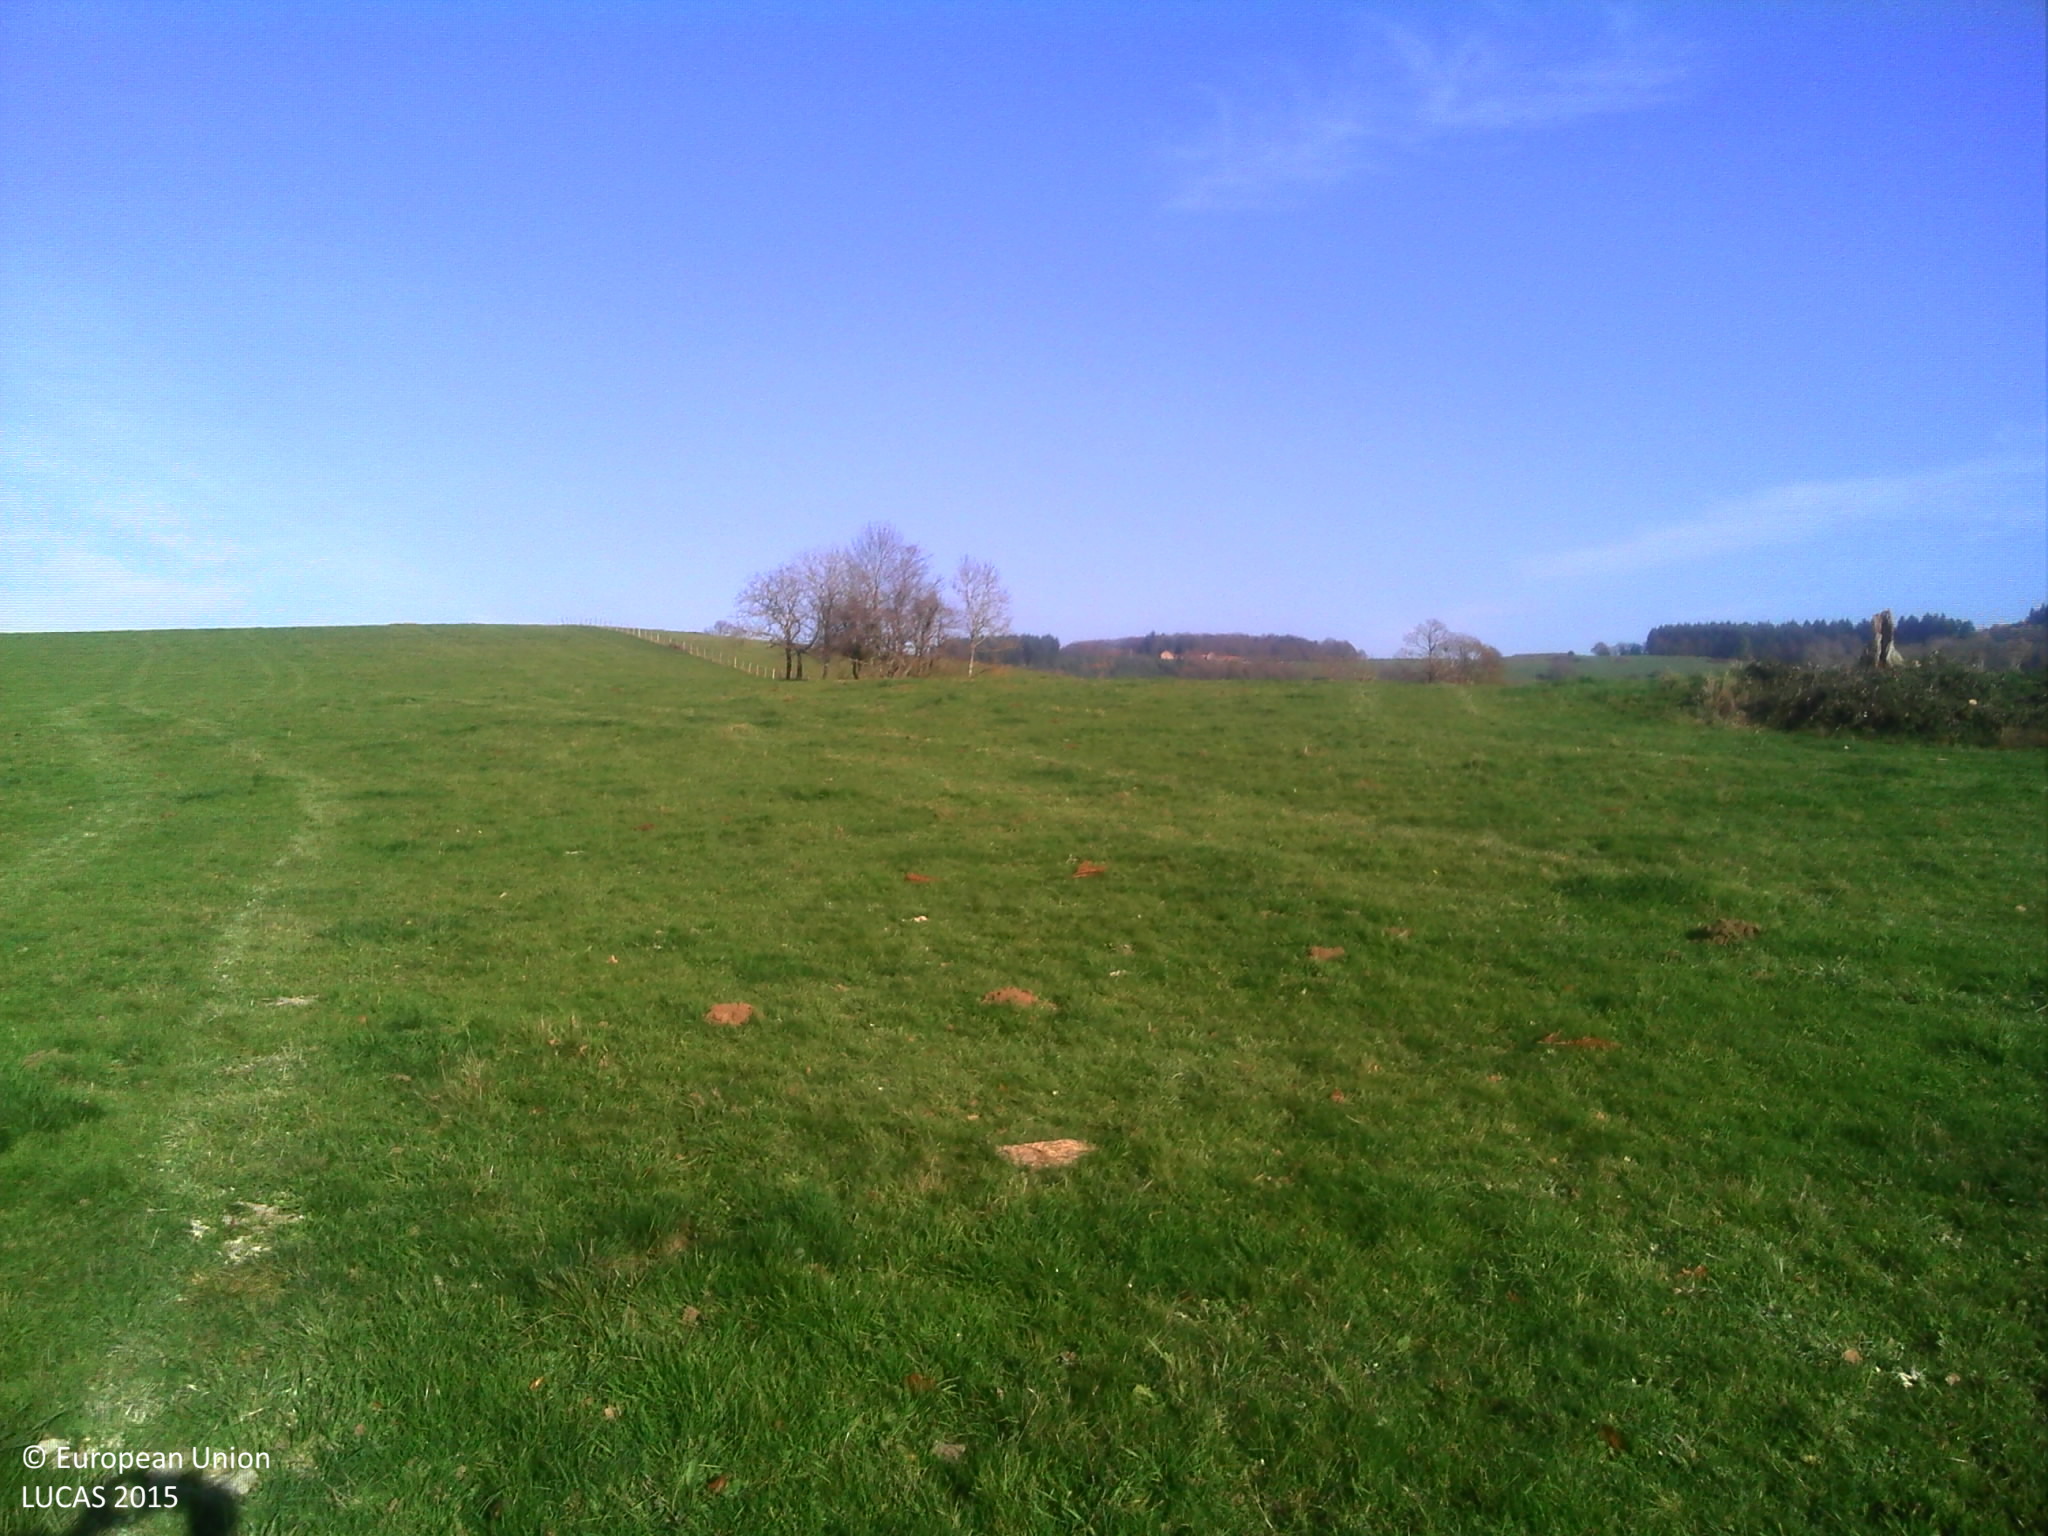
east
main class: Grassland
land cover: Grassland without tree/shrub cover
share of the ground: > 75 %
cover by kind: herbaceous plants 100 %
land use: Agriculture (excluding fallow land and kitchen gardens)
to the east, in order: Grassland without tree/shrub cover; Fences; Grassland without tree/shrub cover; Single bushes/trees; Grassland without tree/shrub cover; Fences; Grassland without tree/shrub cover
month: November
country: FR
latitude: 46.1292
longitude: 3.6974
